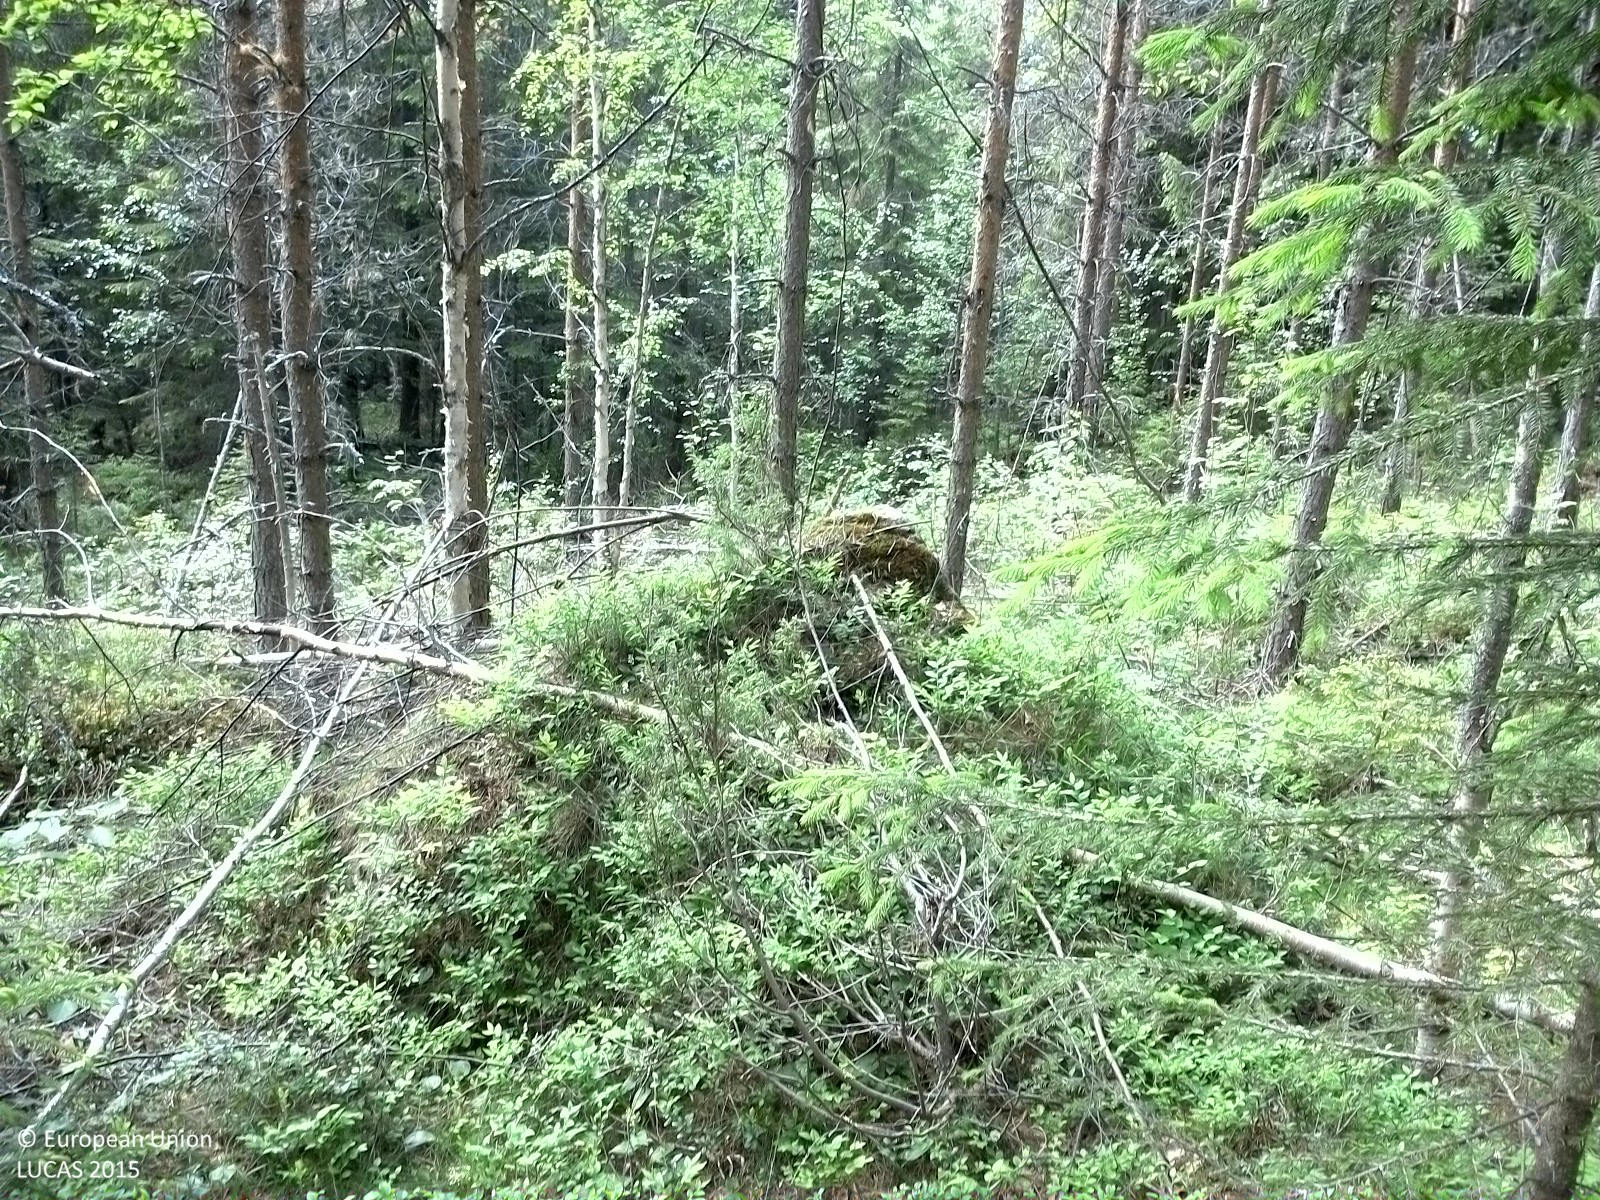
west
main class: Woodland
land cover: Pine dominated coniferous woodland
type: boreal forest
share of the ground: 25 - 50 %
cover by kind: coniferous forest trees 45 %, shrubs 40 %, herbaceous plants 10 %, broadleaved forest trees 5 %
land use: Forestry
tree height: > 5 m
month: June
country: SE
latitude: 62.1877
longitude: 16.3784
